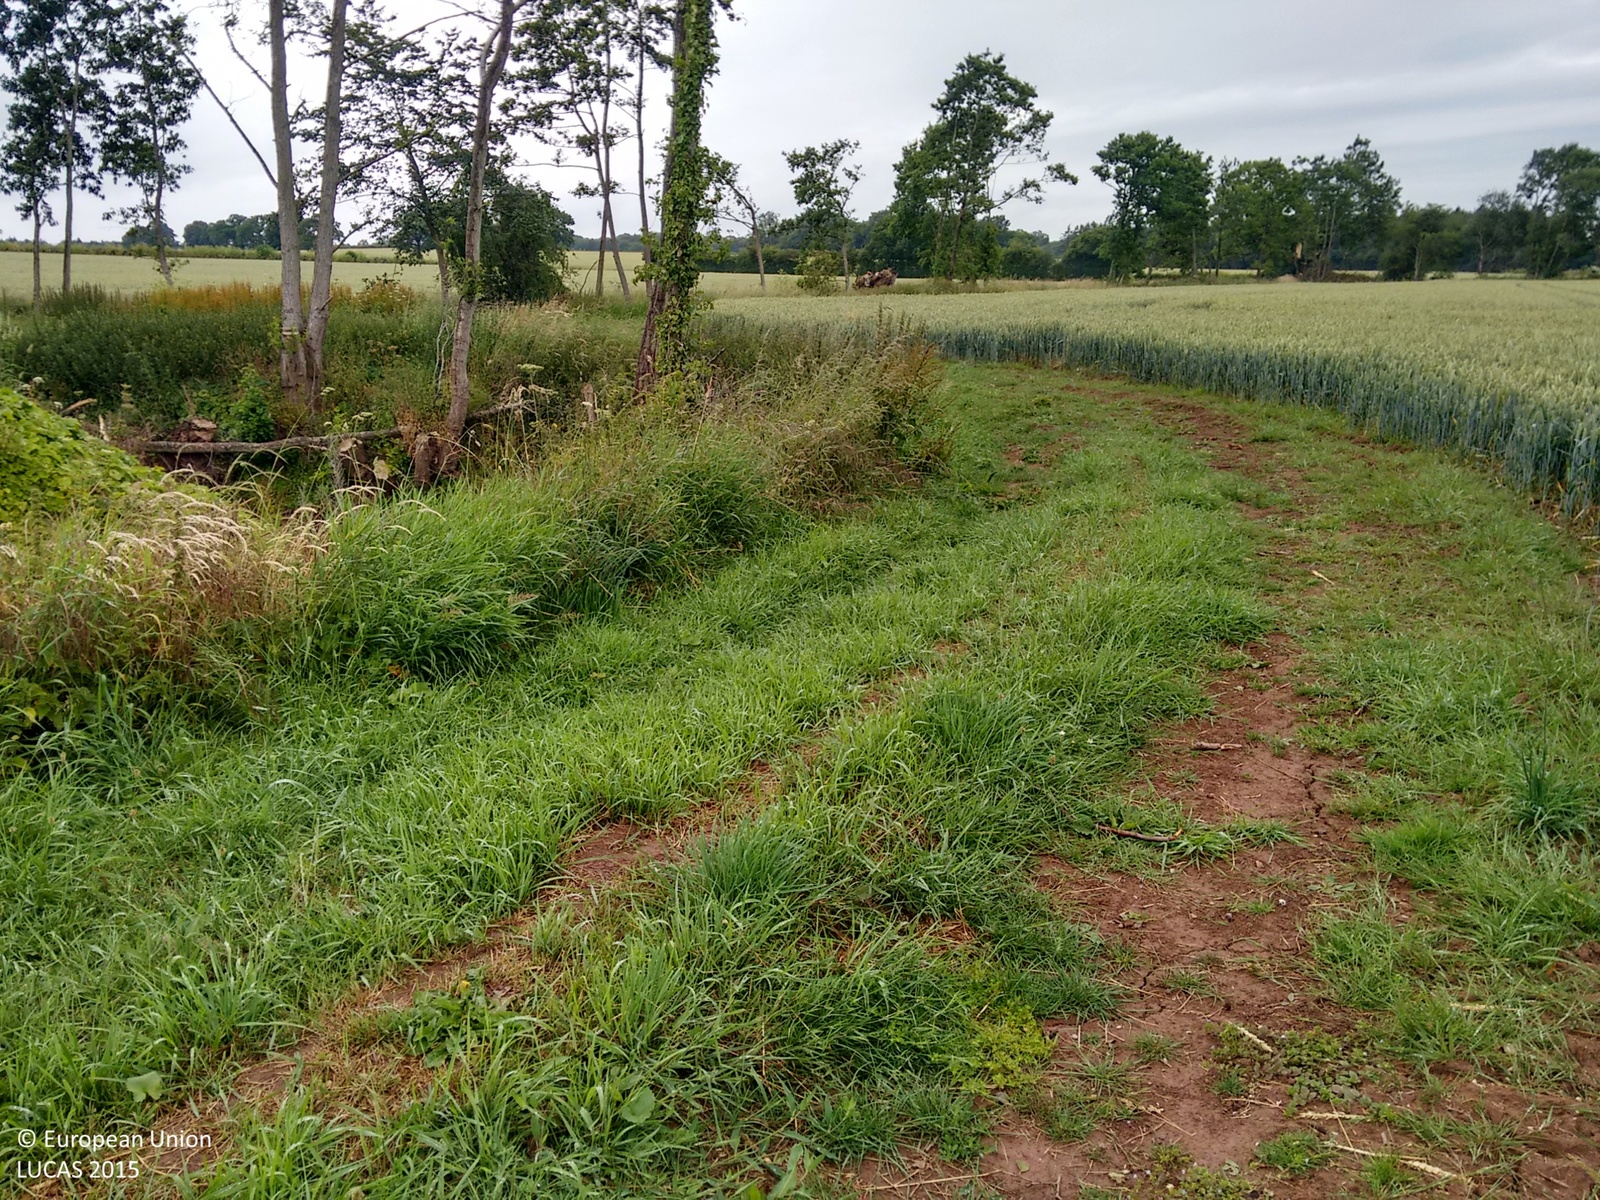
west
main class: Cropland
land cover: Common wheat
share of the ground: > 75 %
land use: Agriculture (excluding fallow land and kitchen gardens)
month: July
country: GB
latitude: 52.1085
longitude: -2.5513
